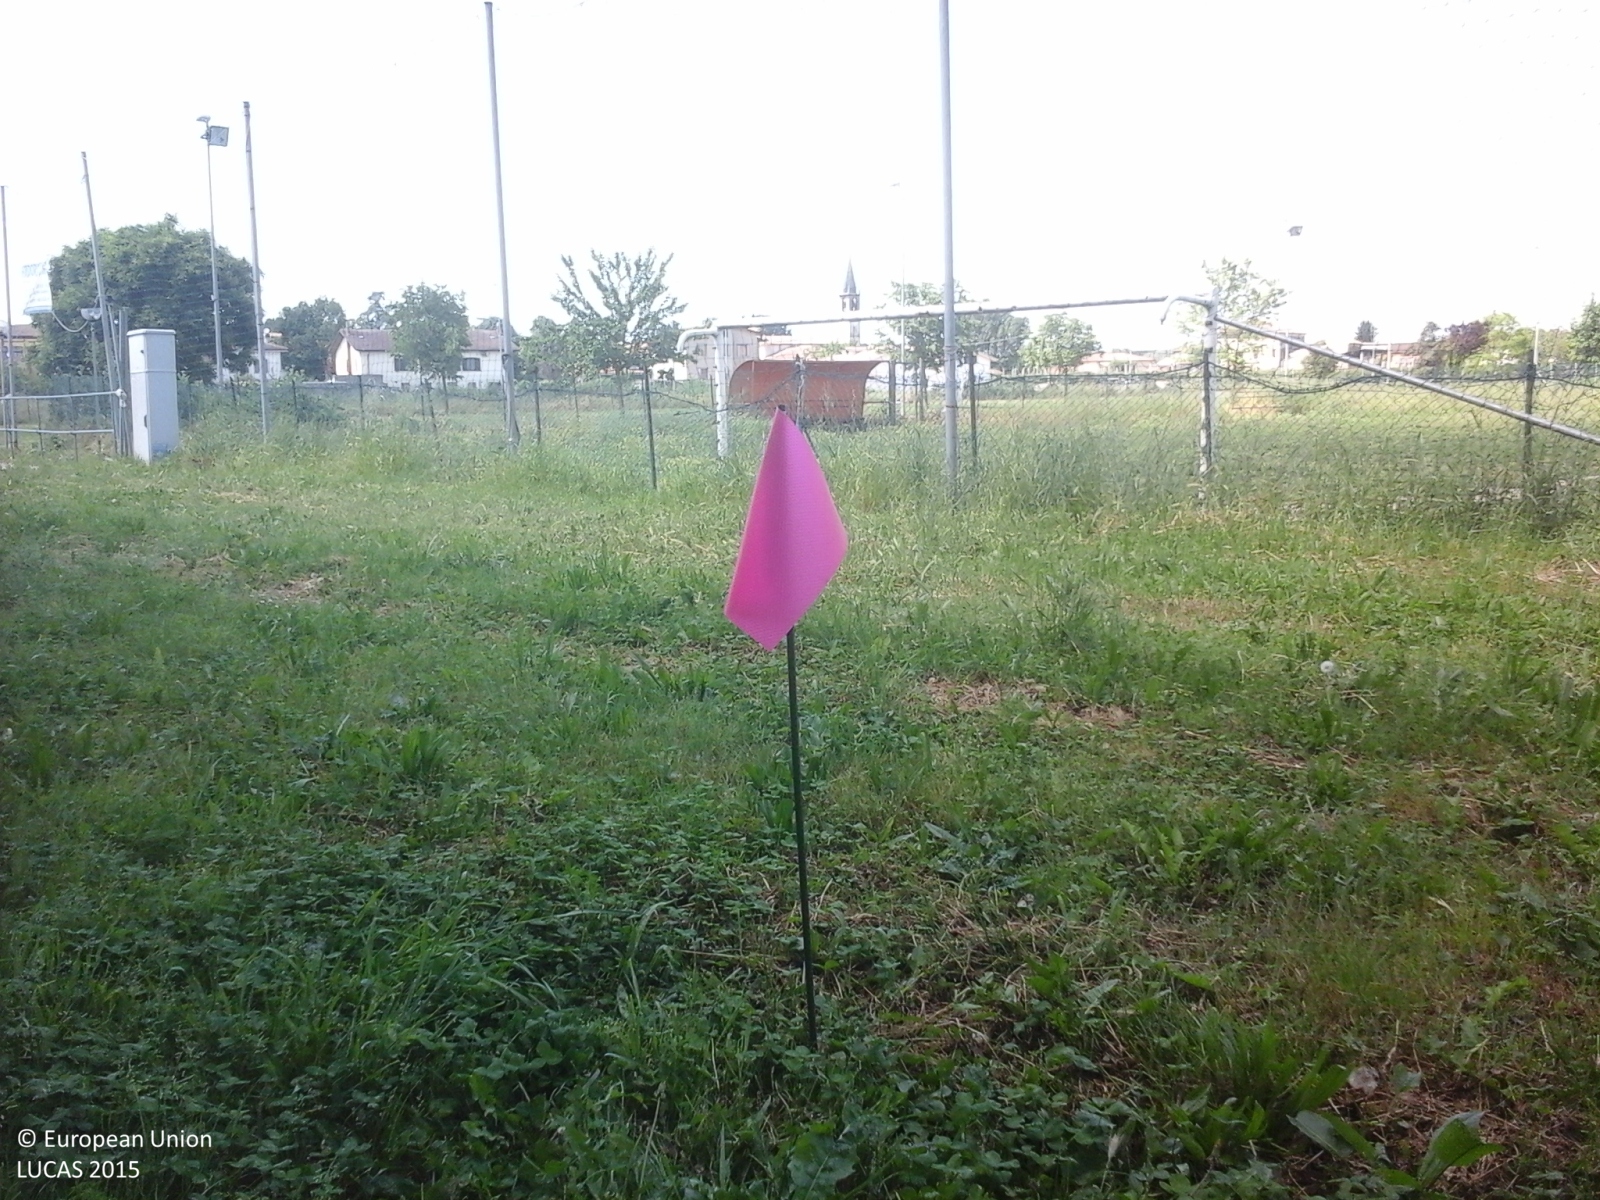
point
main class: Grassland
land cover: Grassland without tree/shrub cover
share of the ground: > 75 %
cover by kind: herbaceous plants 100 %
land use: Sport
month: May
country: IT
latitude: 45.0327
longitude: 10.7981
